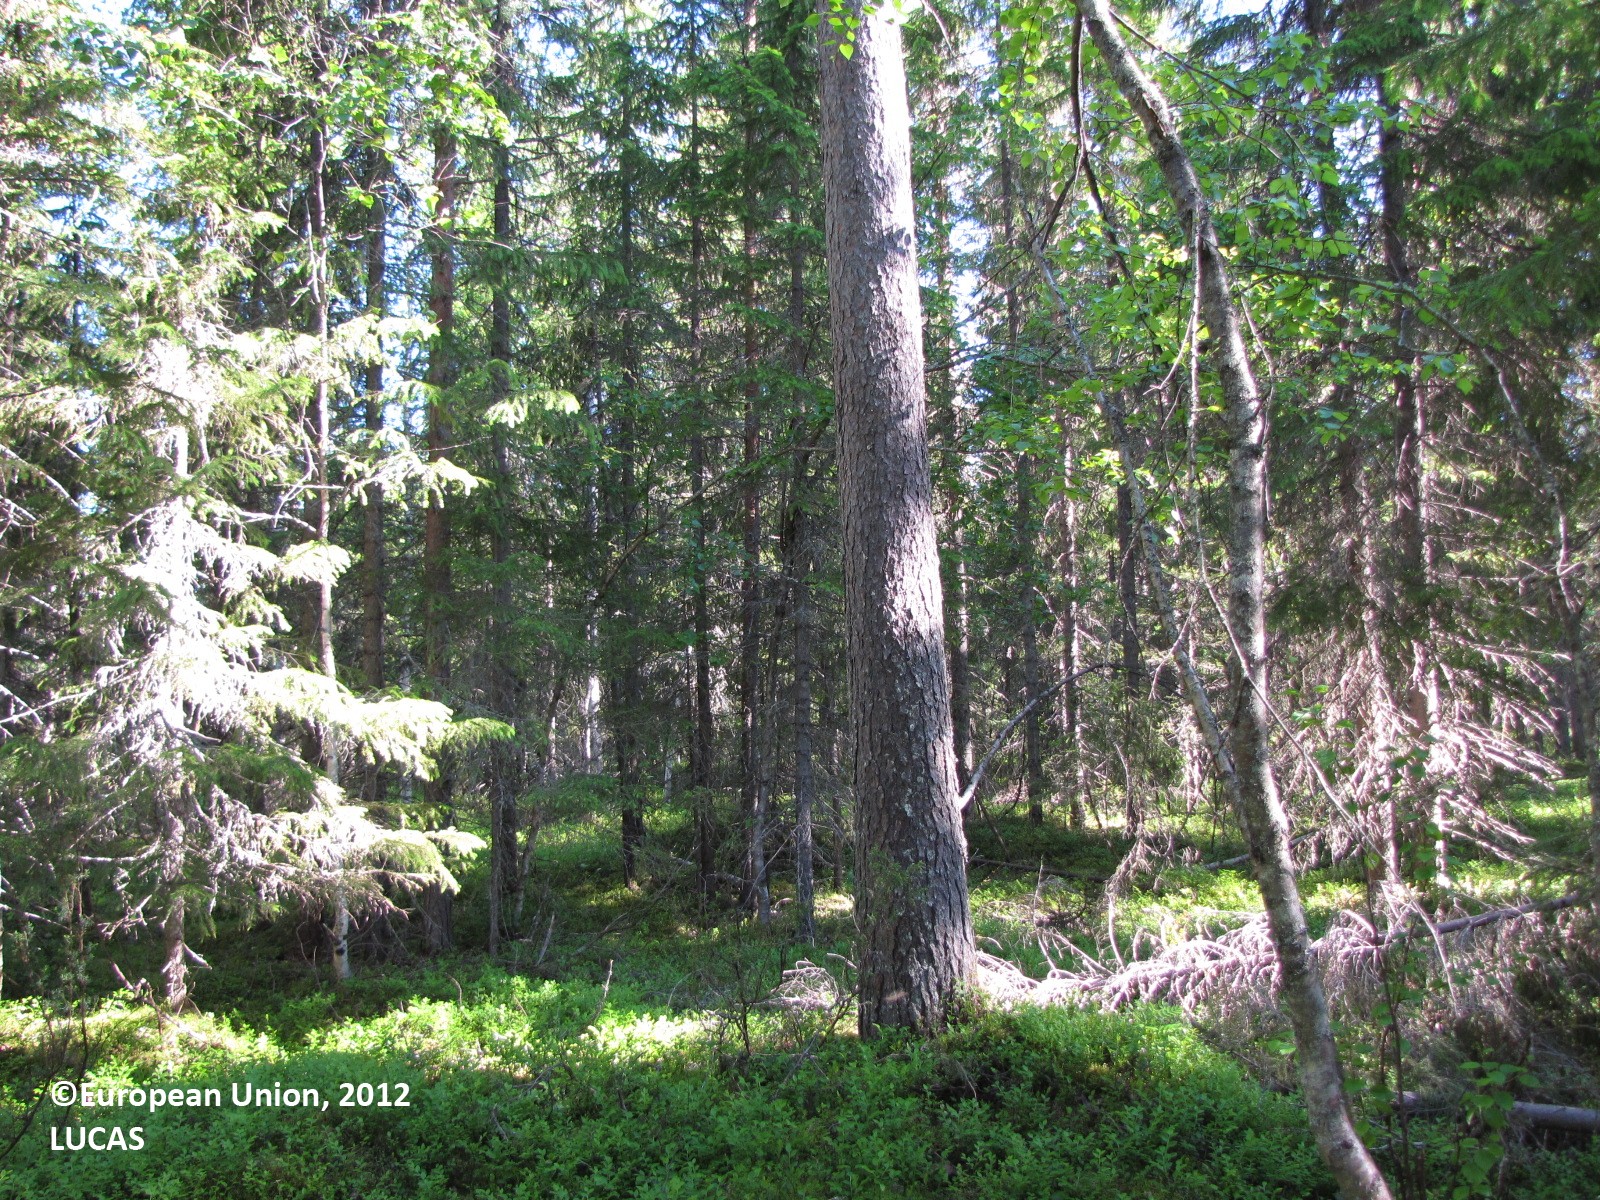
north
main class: Woodland
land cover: Spruce dominated coniferous woodland
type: boreal forest
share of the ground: 50 - 75 %
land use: Forestry
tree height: > 5 m
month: July
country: FI
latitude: 66.4170
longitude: 24.7670
